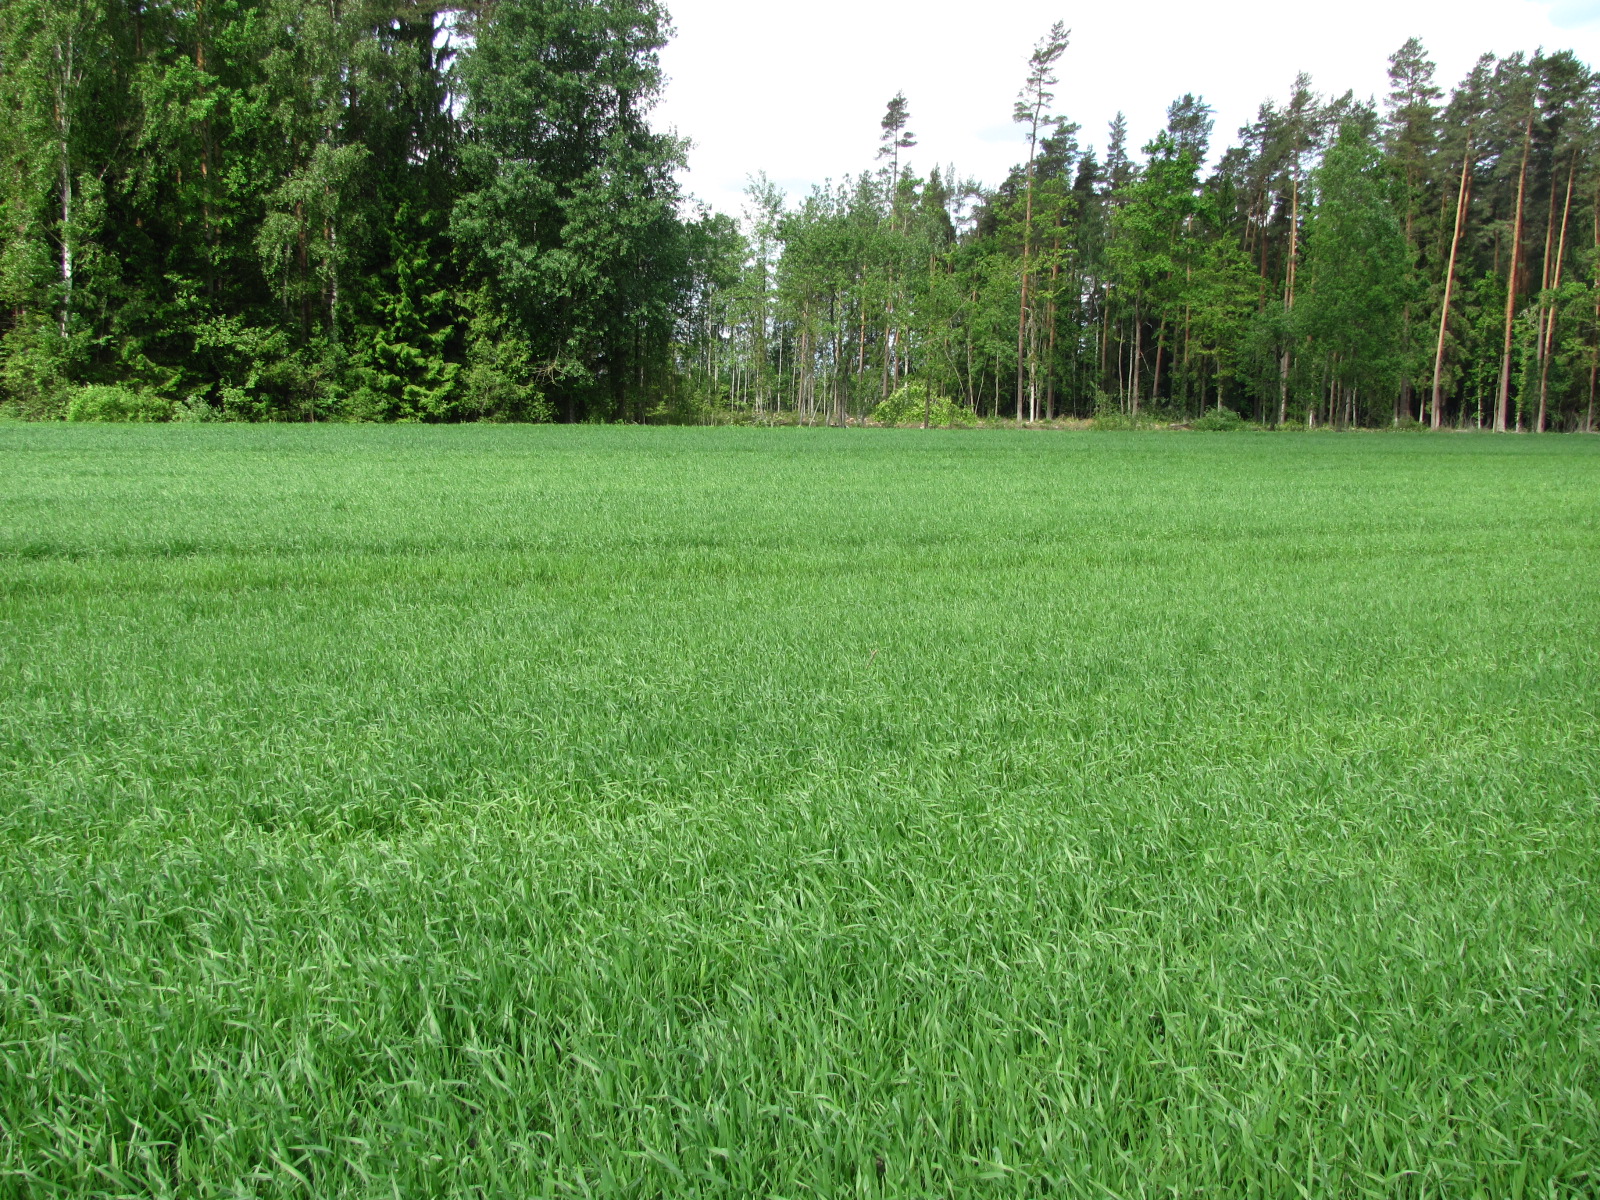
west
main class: Cropland
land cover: Common wheat
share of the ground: > 75 %
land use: Agriculture (excluding fallow land and kitchen gardens)
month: June
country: LV
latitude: 56.6899
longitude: 23.8781
